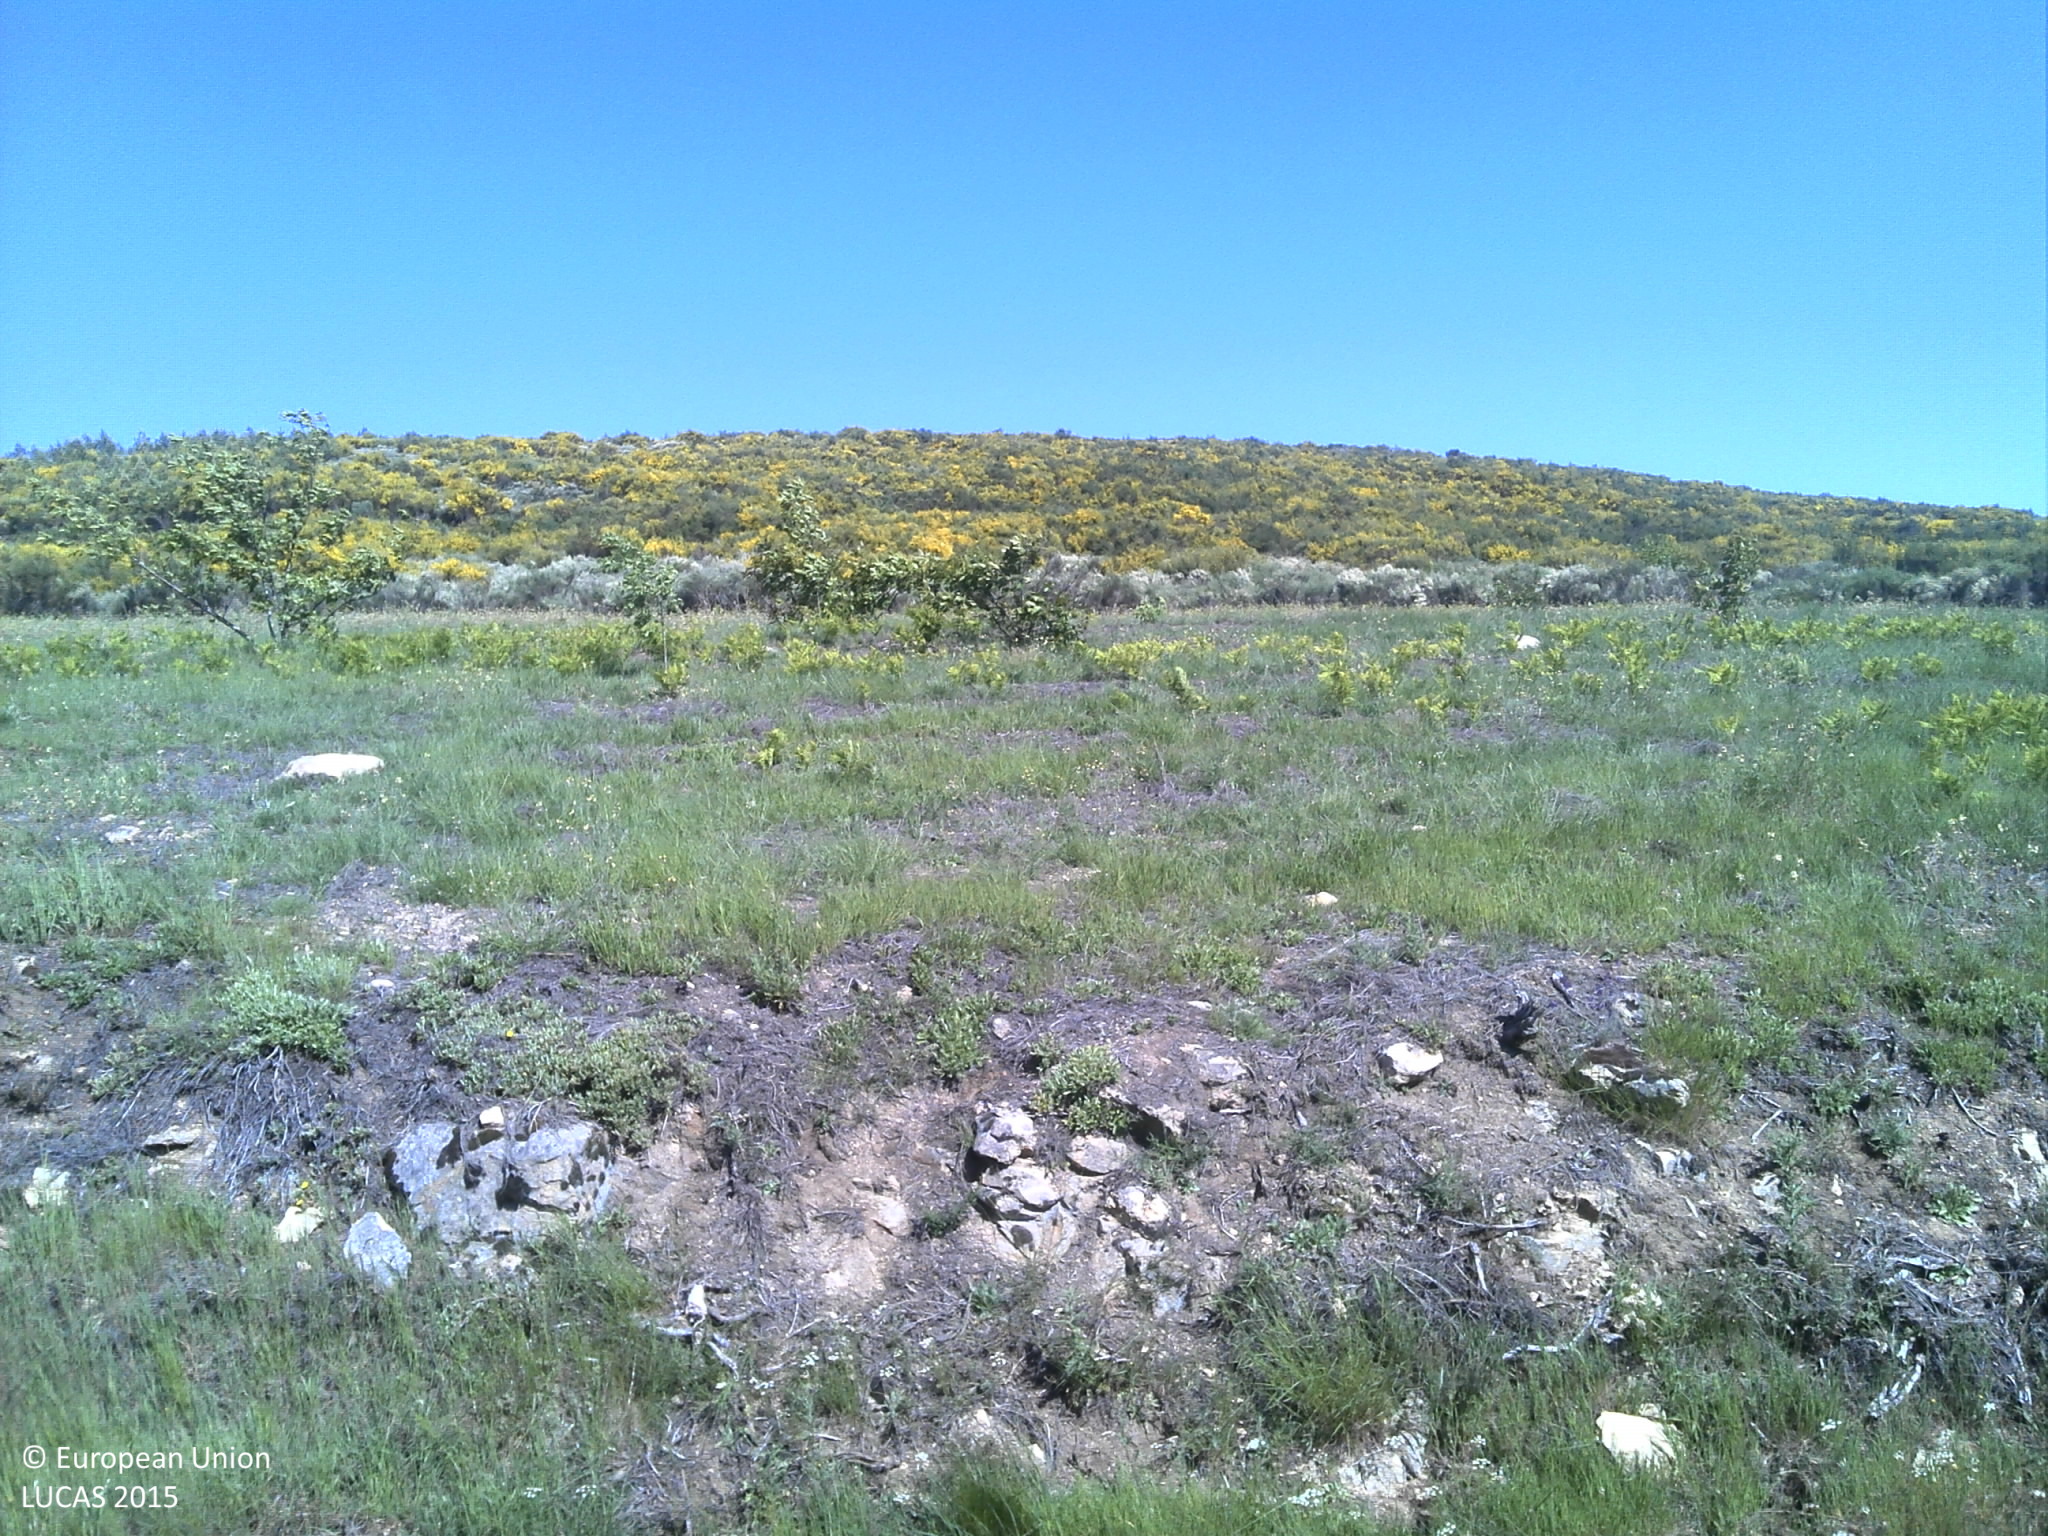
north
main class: Shrubland
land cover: Shrubland without tree cover
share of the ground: > 75 %
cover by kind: shrubs 75 %, herbaceous plants 15 %, unconsolidated bare surface 10 %
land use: Semi-natural and natural areas not in use
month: May
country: PT
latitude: 40.5429
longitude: -7.4071
